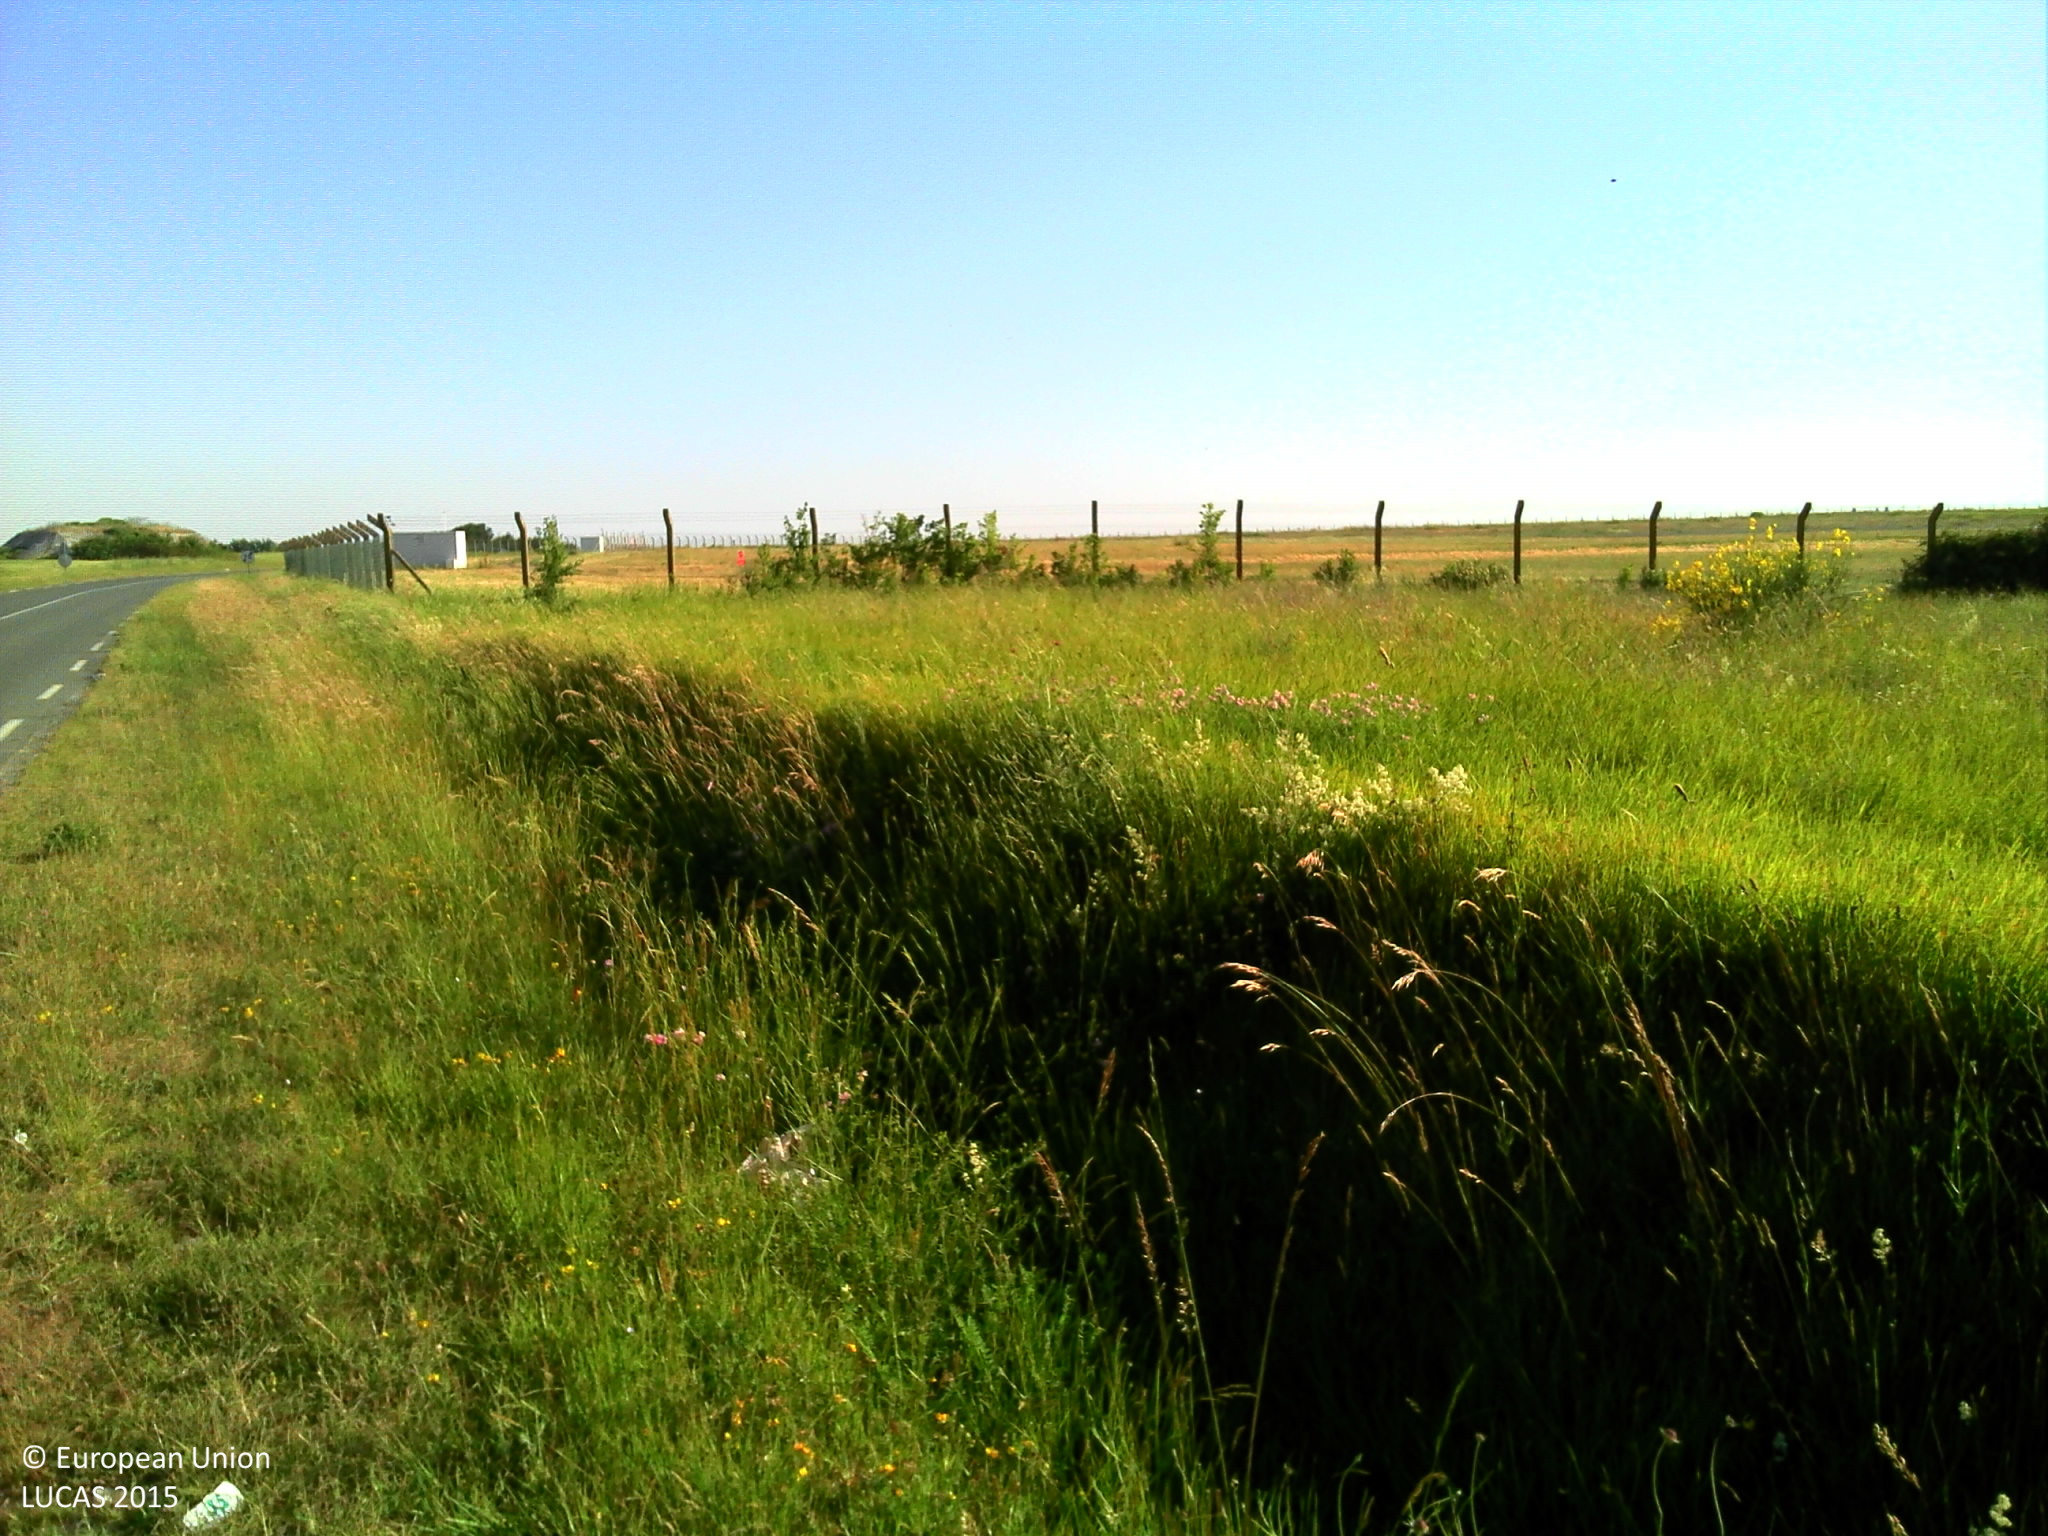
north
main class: Grassland
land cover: Spontaneously vegetated surfaces
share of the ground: > 75 %
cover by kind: herbaceous plants 95 %, shrubs 5 %
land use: Road transport
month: June
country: FR
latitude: 46.1778
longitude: -1.2119
